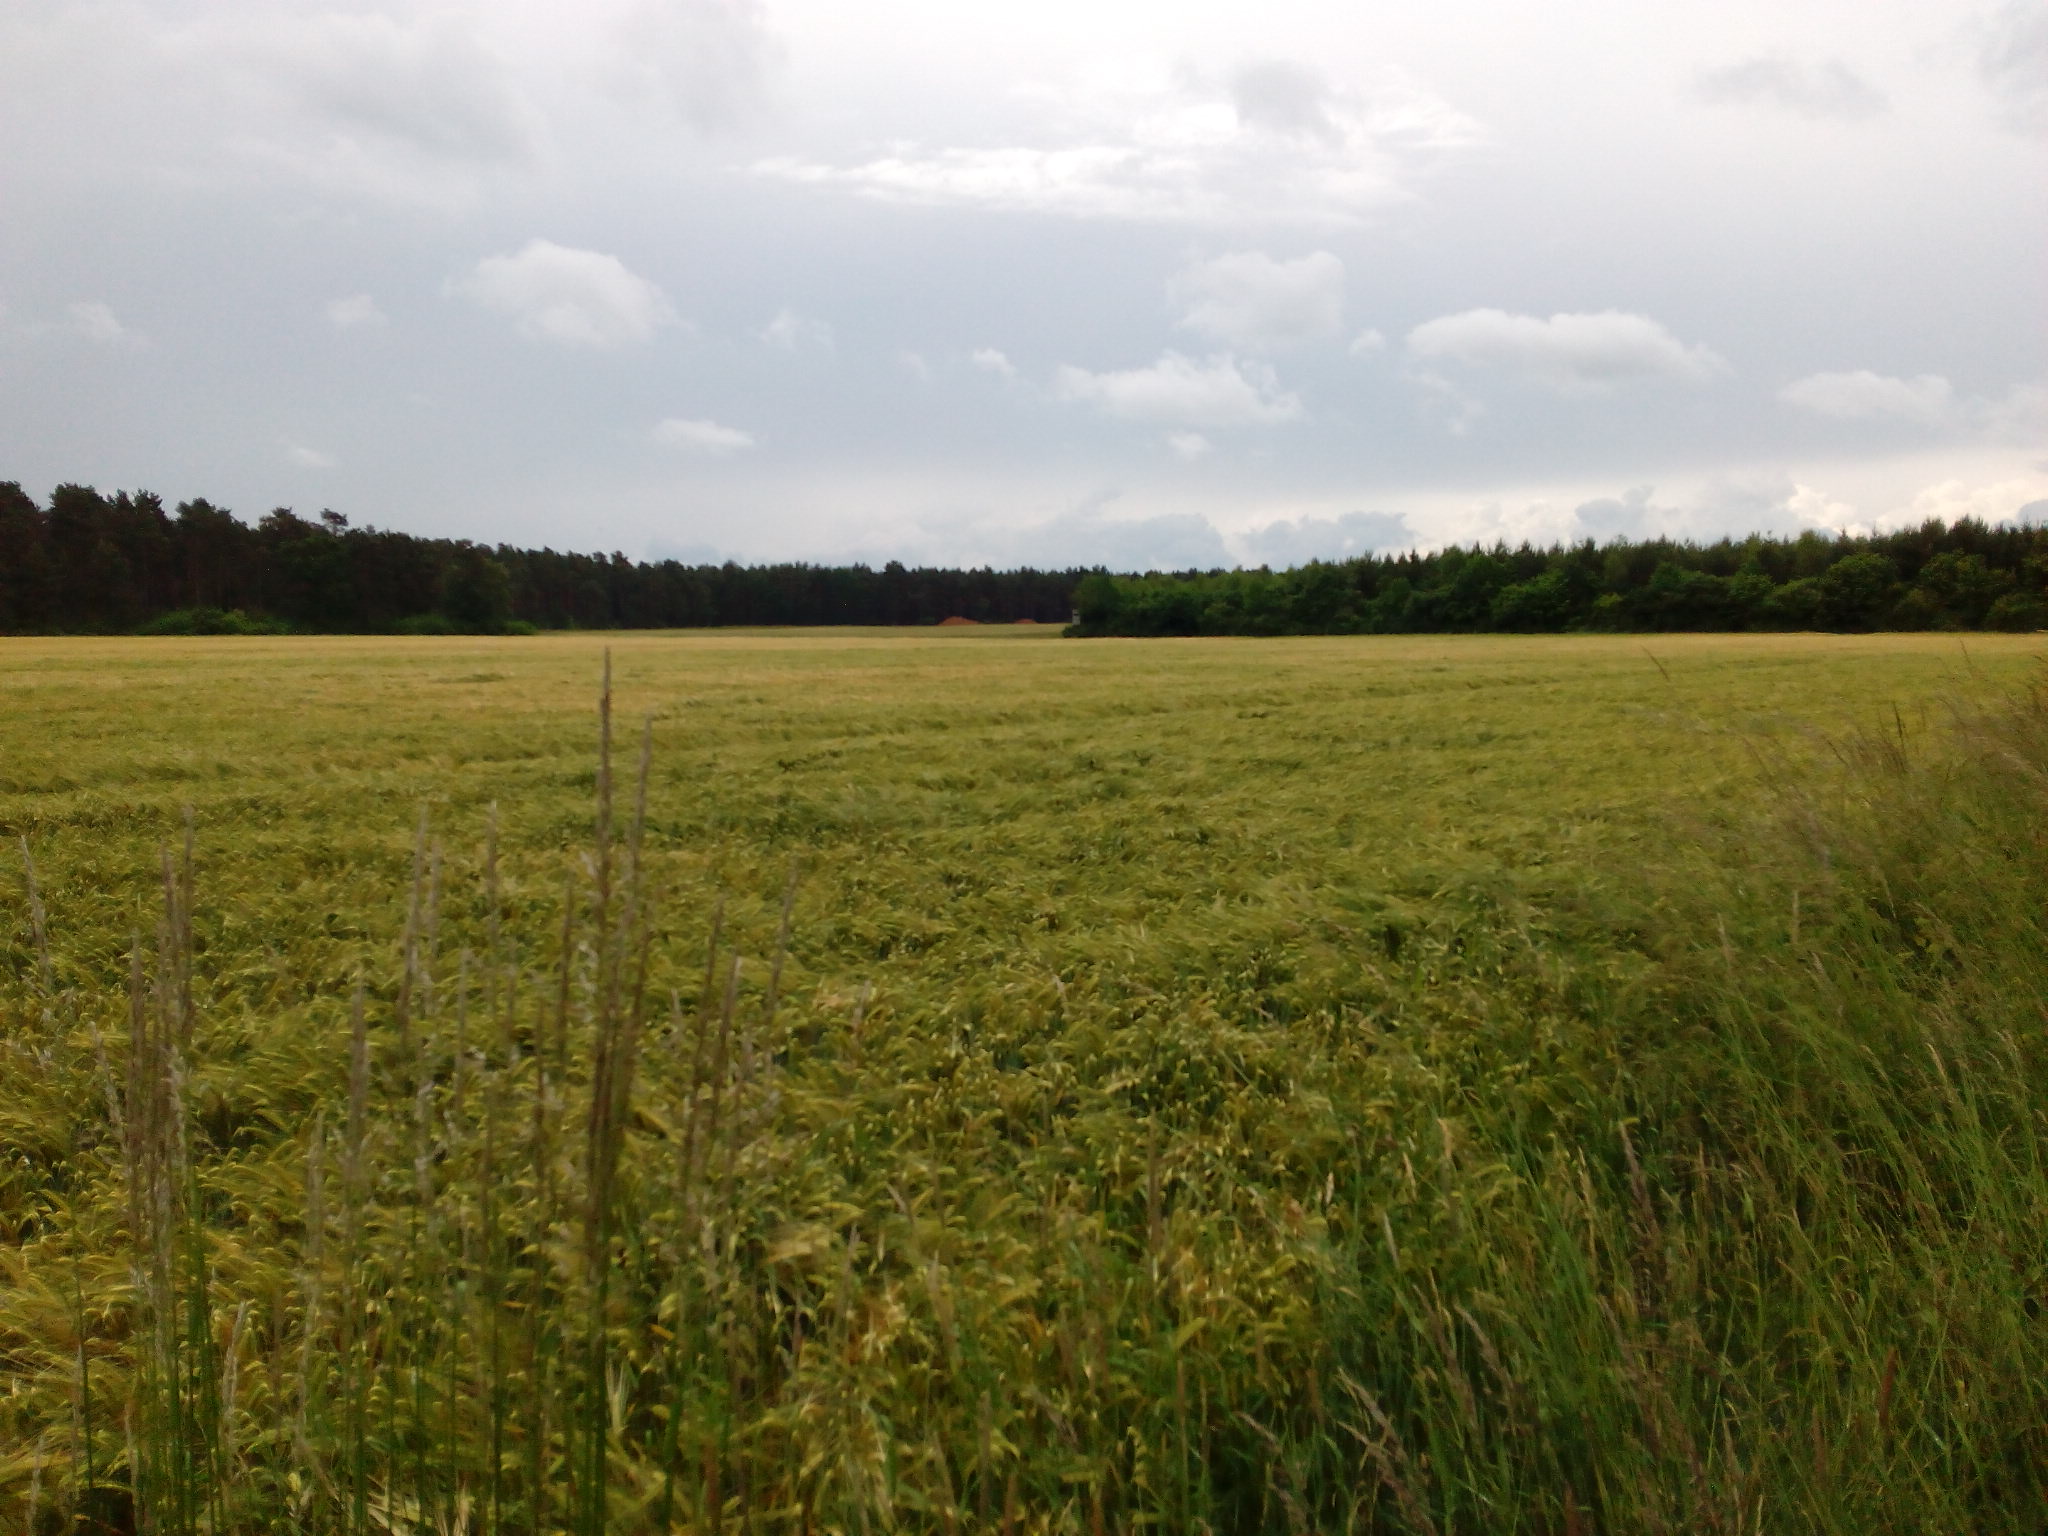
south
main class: Cropland
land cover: Barley
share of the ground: > 75 %
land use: Agriculture (excluding fallow land and kitchen gardens)
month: June
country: DE
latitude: 52.7728
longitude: 9.9259
